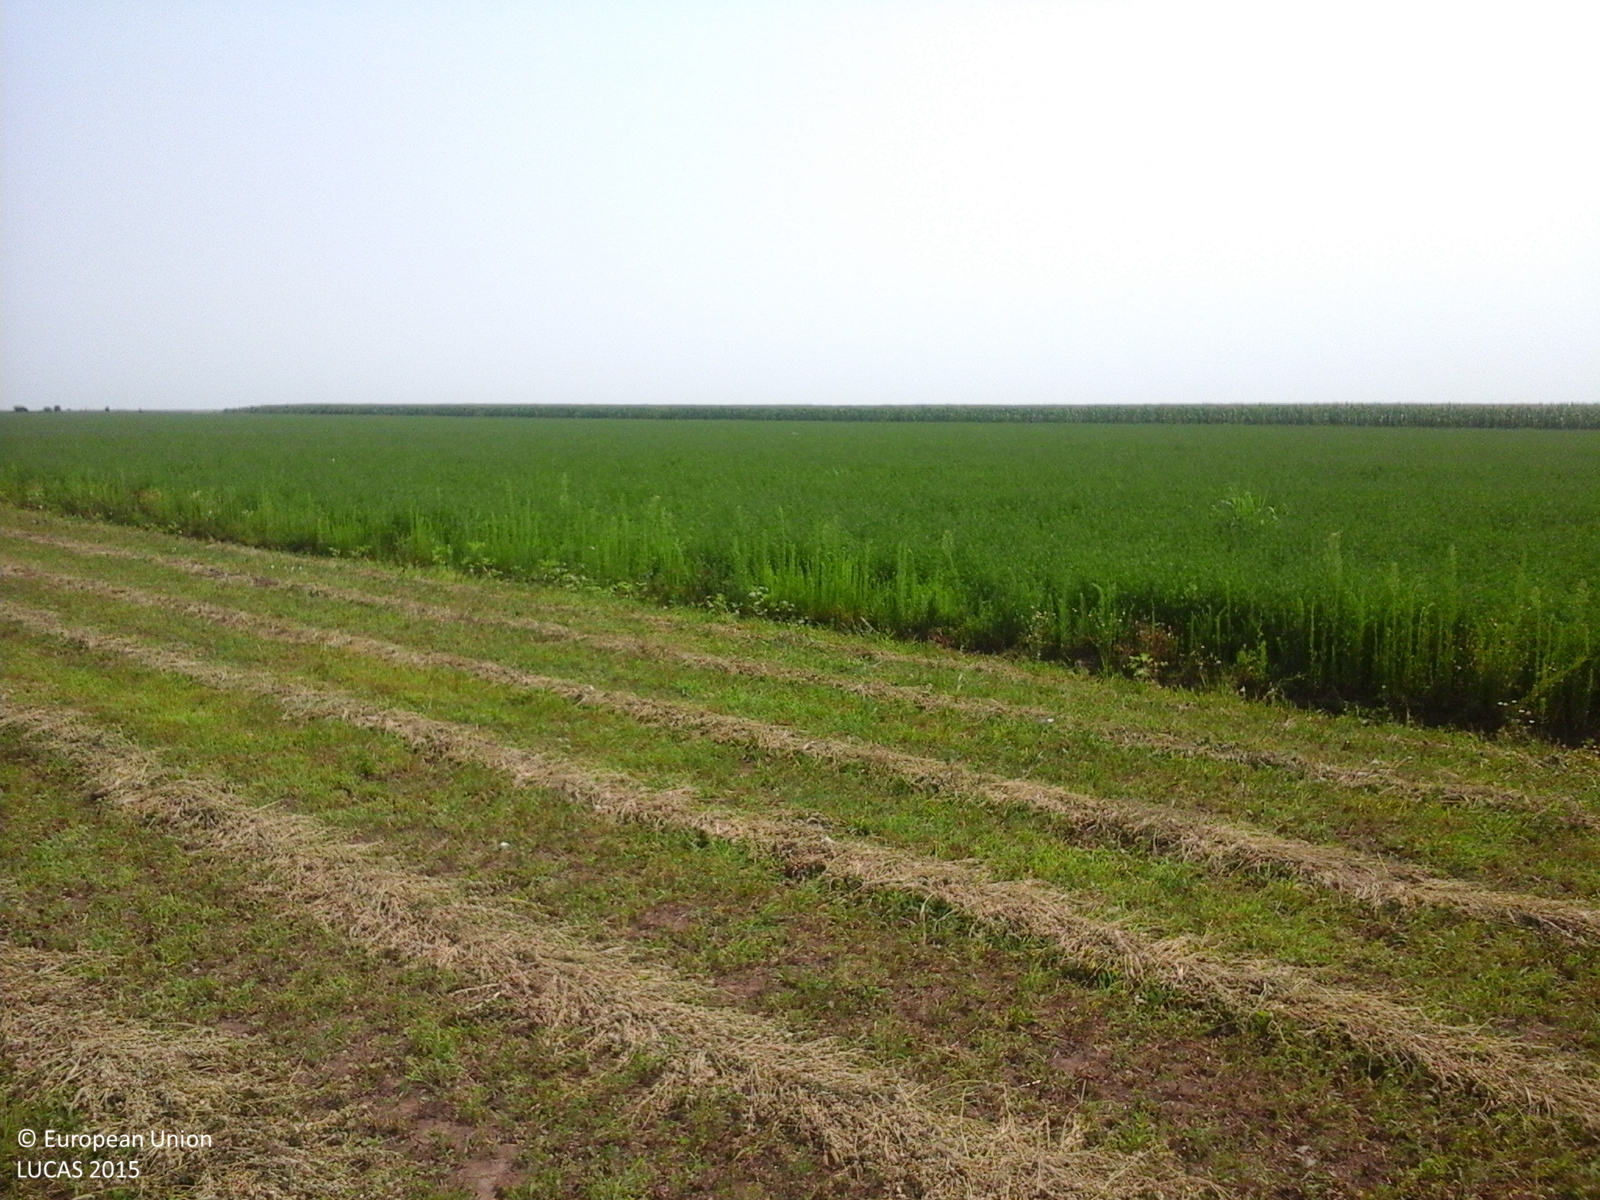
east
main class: Cropland
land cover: Lucerne
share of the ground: > 75 %
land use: Agriculture (excluding fallow land and kitchen gardens)
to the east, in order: Lucerne; Tracks; Maize
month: July
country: RO
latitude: 44.8163
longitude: 26.5207
